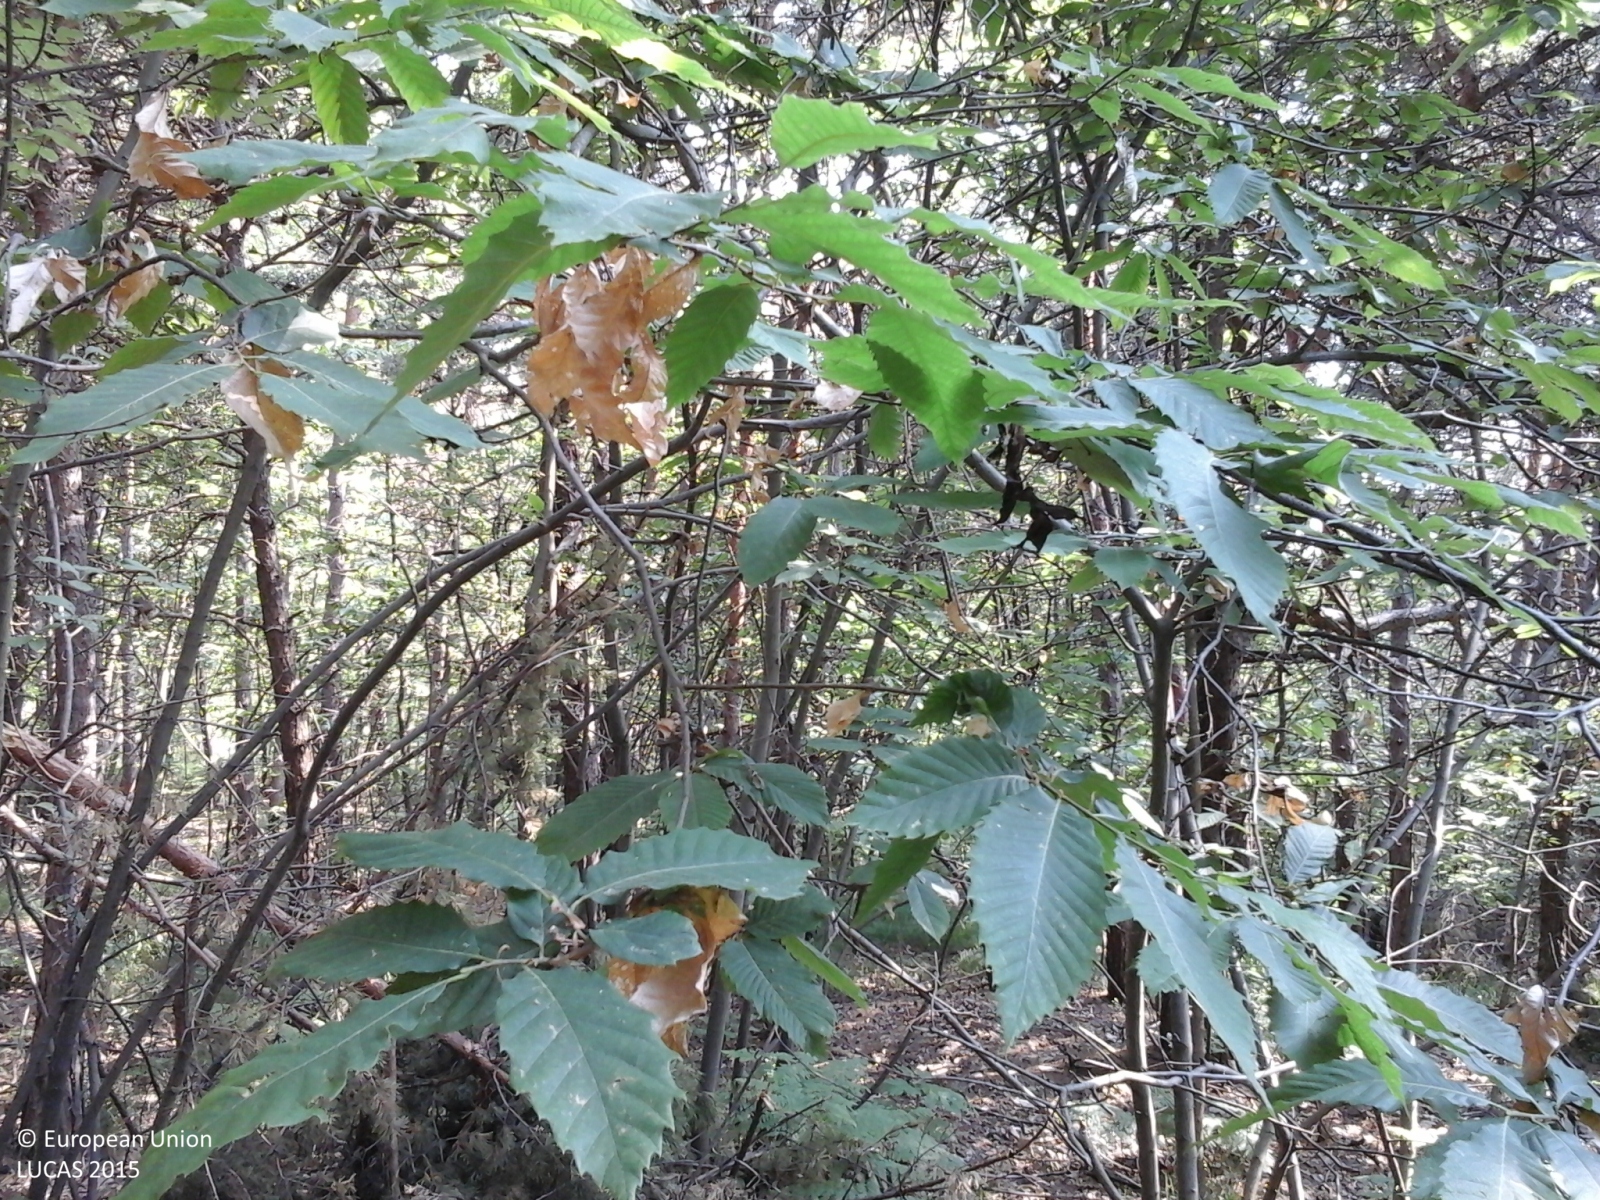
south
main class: Woodland
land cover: Broadleaved woodland
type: thermophilous deciduous forest
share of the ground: > 75 %
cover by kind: broadleaved forest trees 80 %, shrubs 20 %
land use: Forestry
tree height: > 5 m
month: June
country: IT
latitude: 44.5559
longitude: 8.4800
